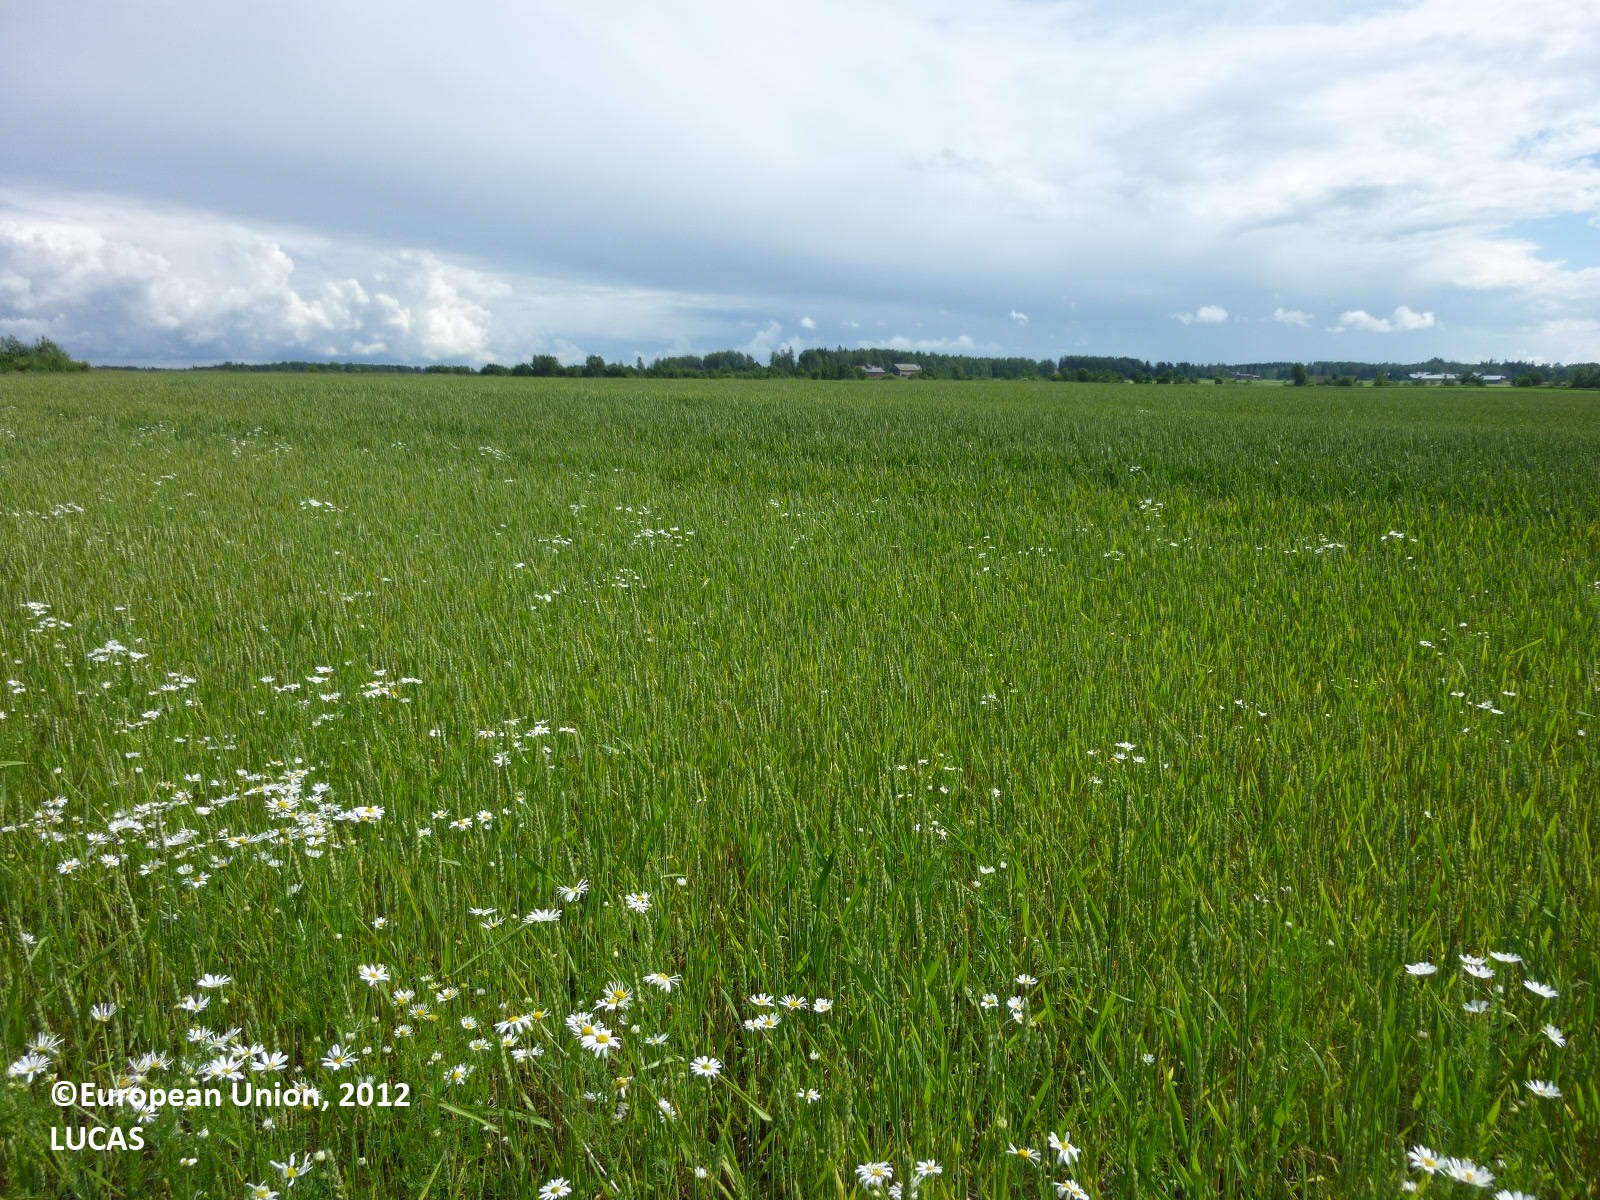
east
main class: Cropland
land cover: Common wheat
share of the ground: > 75 %
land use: Agriculture (excluding fallow land and kitchen gardens)
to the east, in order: Common wheat
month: July
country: FI
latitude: 61.2471
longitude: 22.0794
